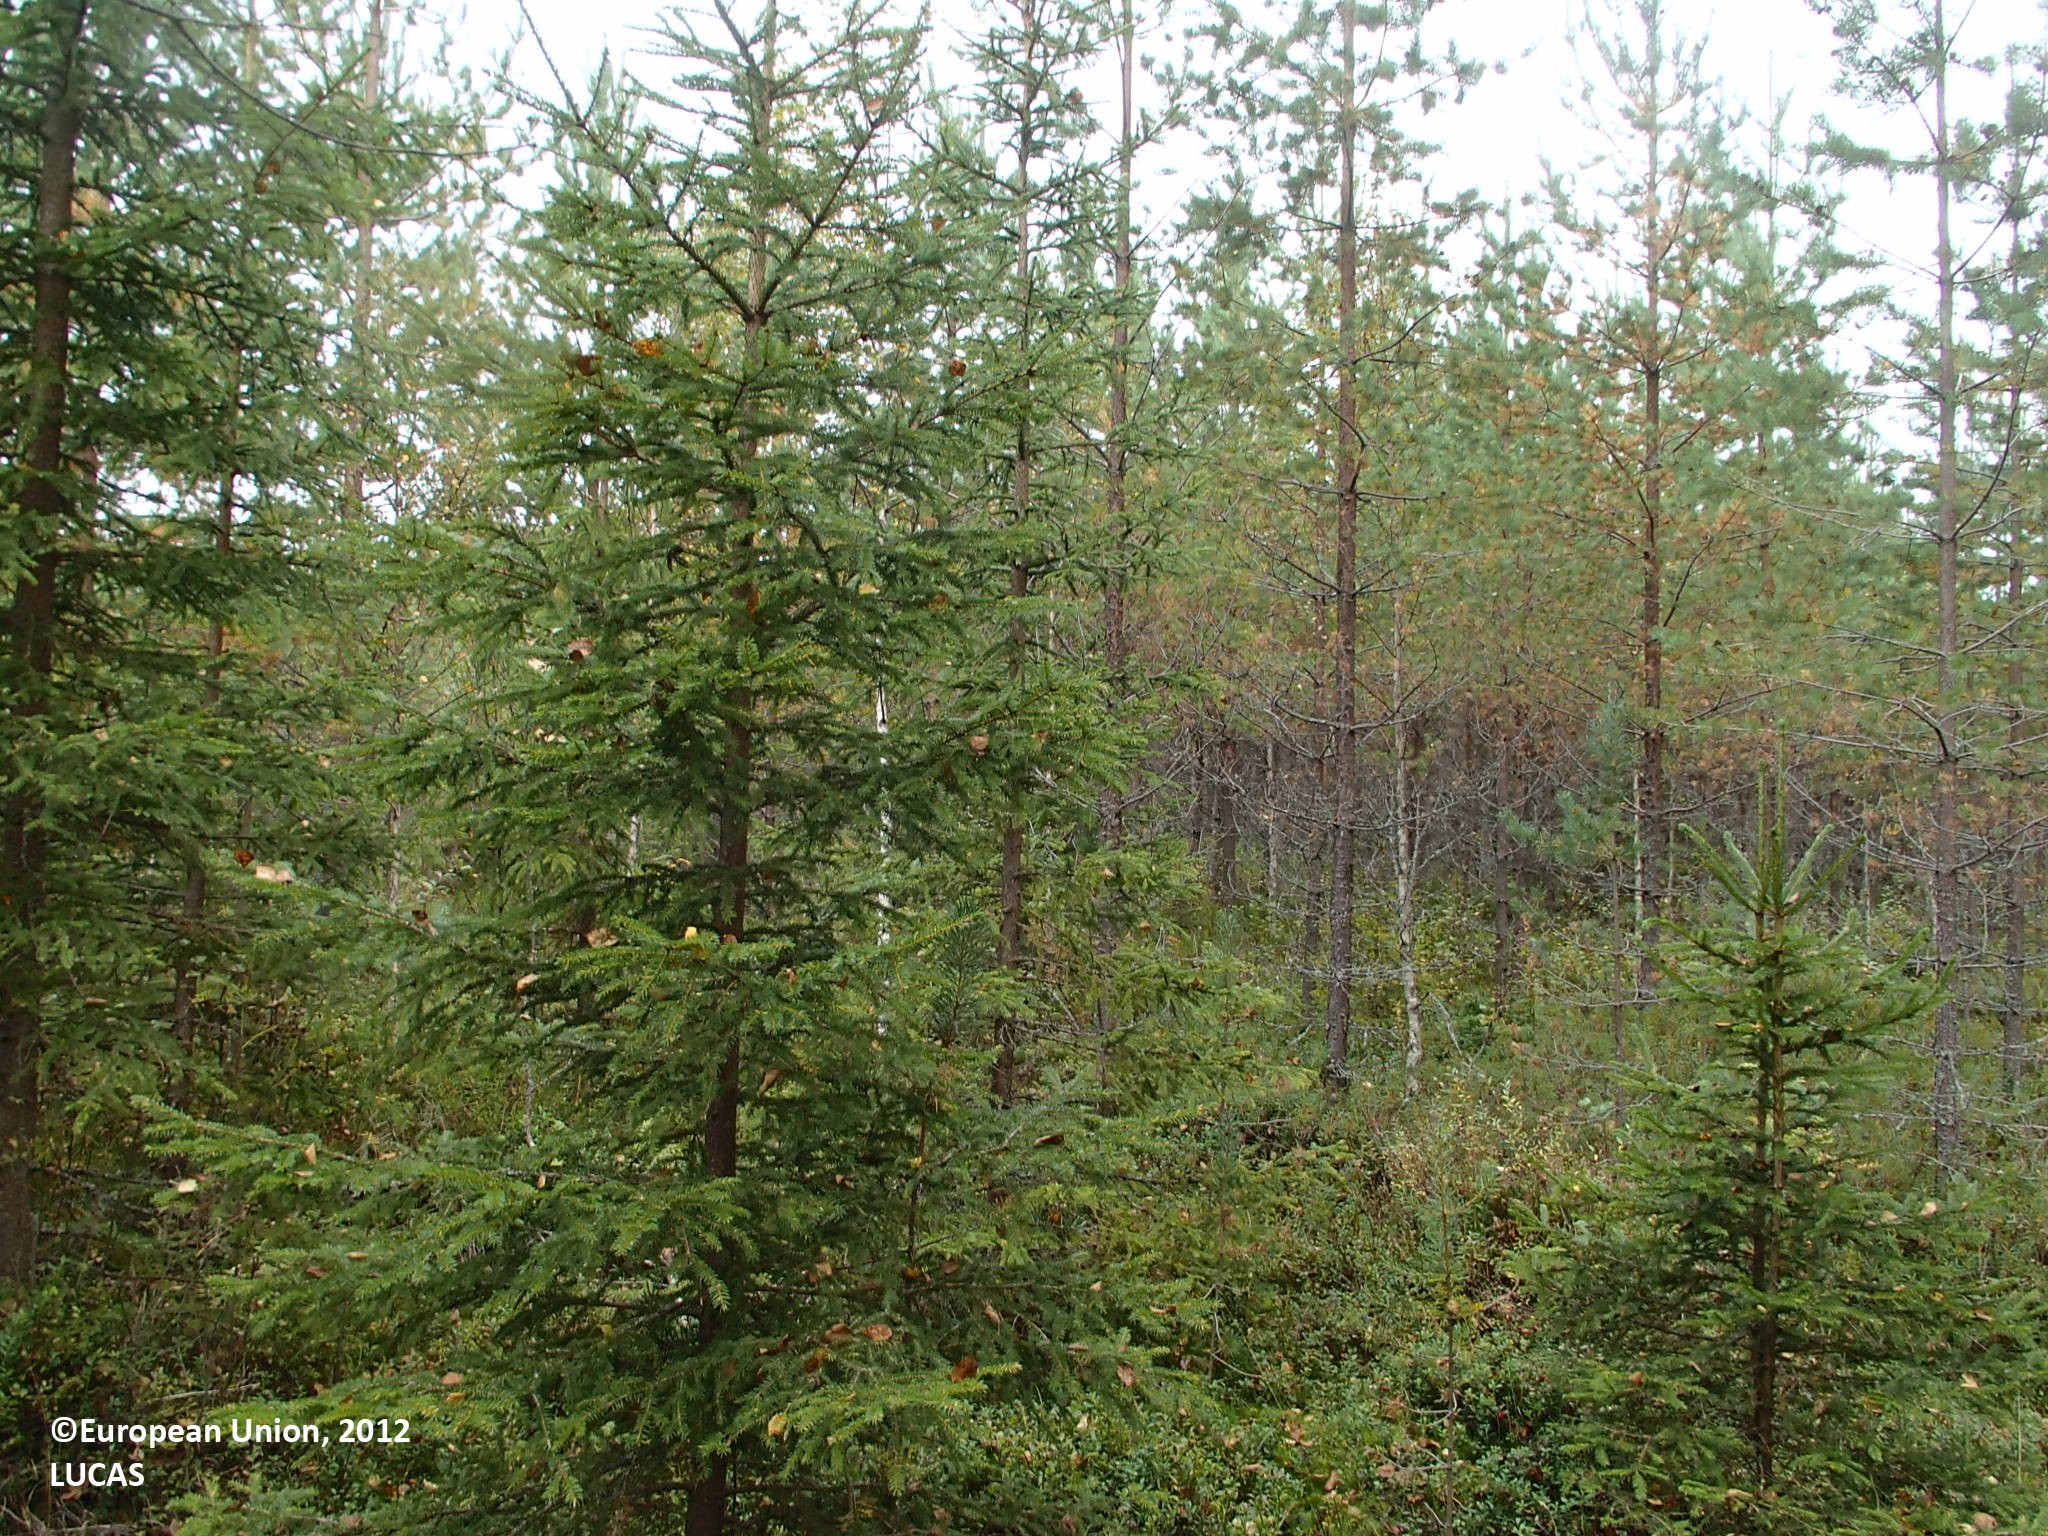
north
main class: Woodland
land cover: Other mixed woodland
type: boreal forest
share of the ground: > 75 %
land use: Forestry
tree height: > 5 m
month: September
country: FI
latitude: 63.8214
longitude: 25.9763
